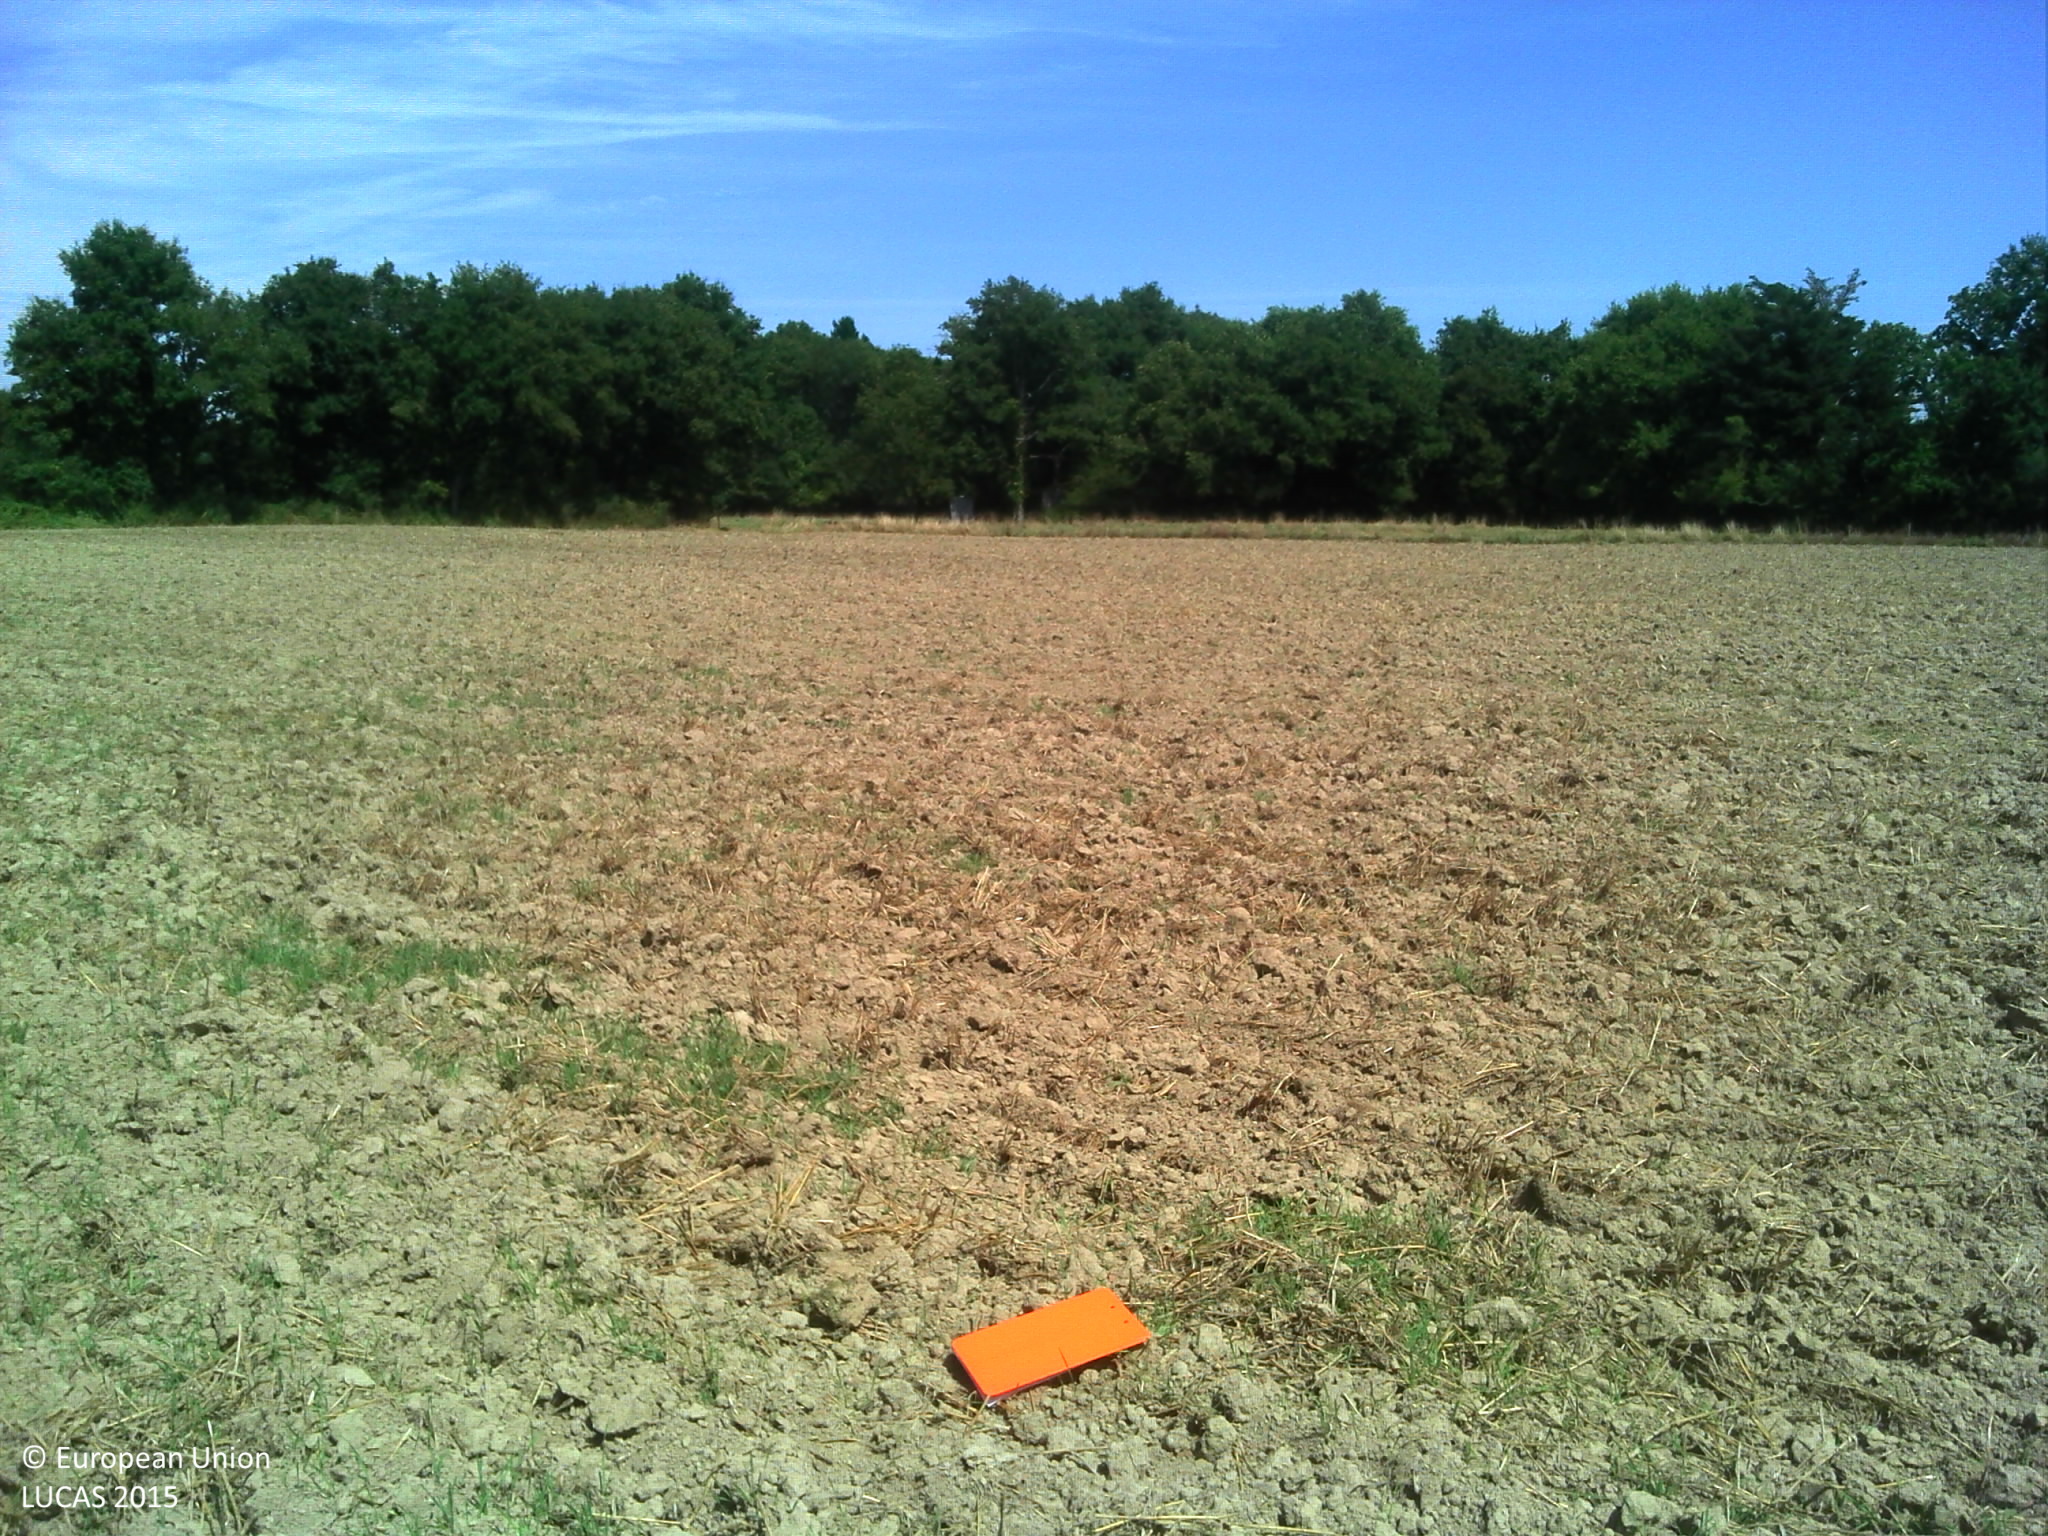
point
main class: Cropland
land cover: Common wheat
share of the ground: > 75 %
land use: Agriculture (excluding fallow land and kitchen gardens)
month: August
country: FR
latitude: 46.7544
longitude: -1.6001
